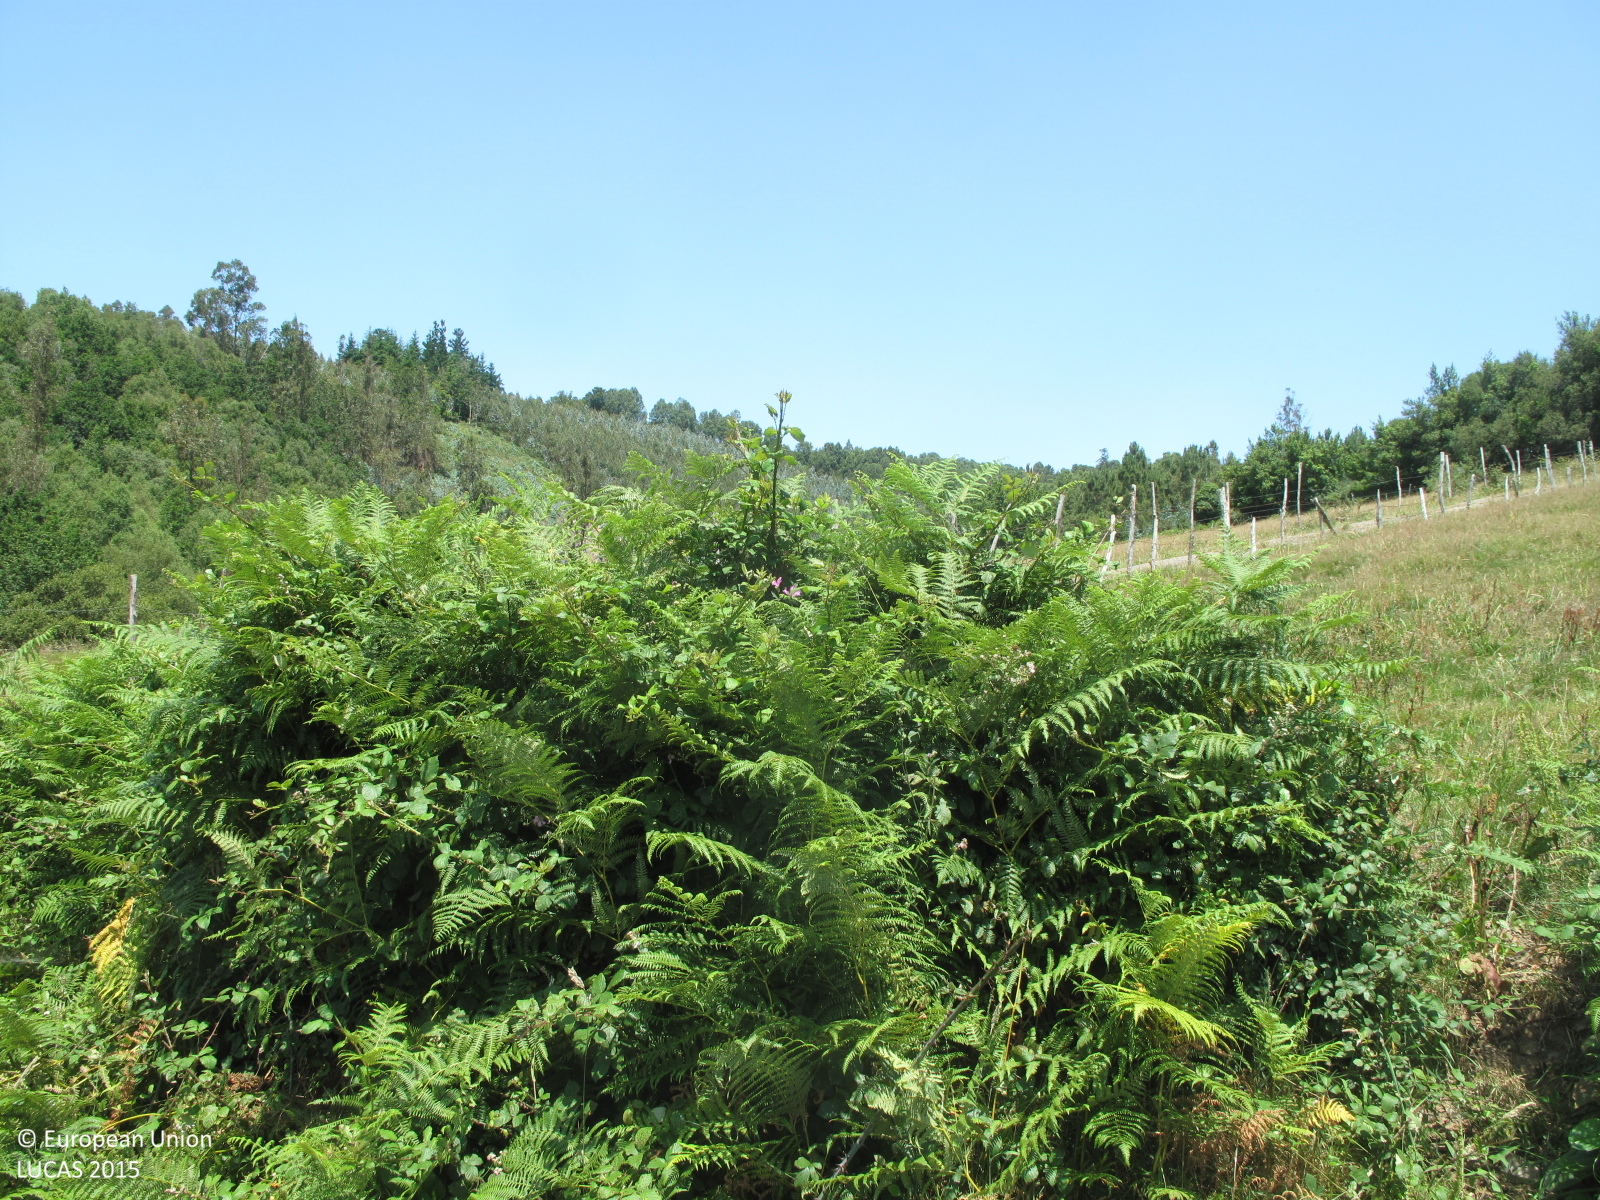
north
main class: Grassland
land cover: Grassland without tree/shrub cover
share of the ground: > 75 %
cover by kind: herbaceous plants 95 %, unconsolidated bare surface 5 %
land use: Agriculture (excluding fallow land and kitchen gardens)
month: July
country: ES
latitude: 43.5605
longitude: -7.8577
